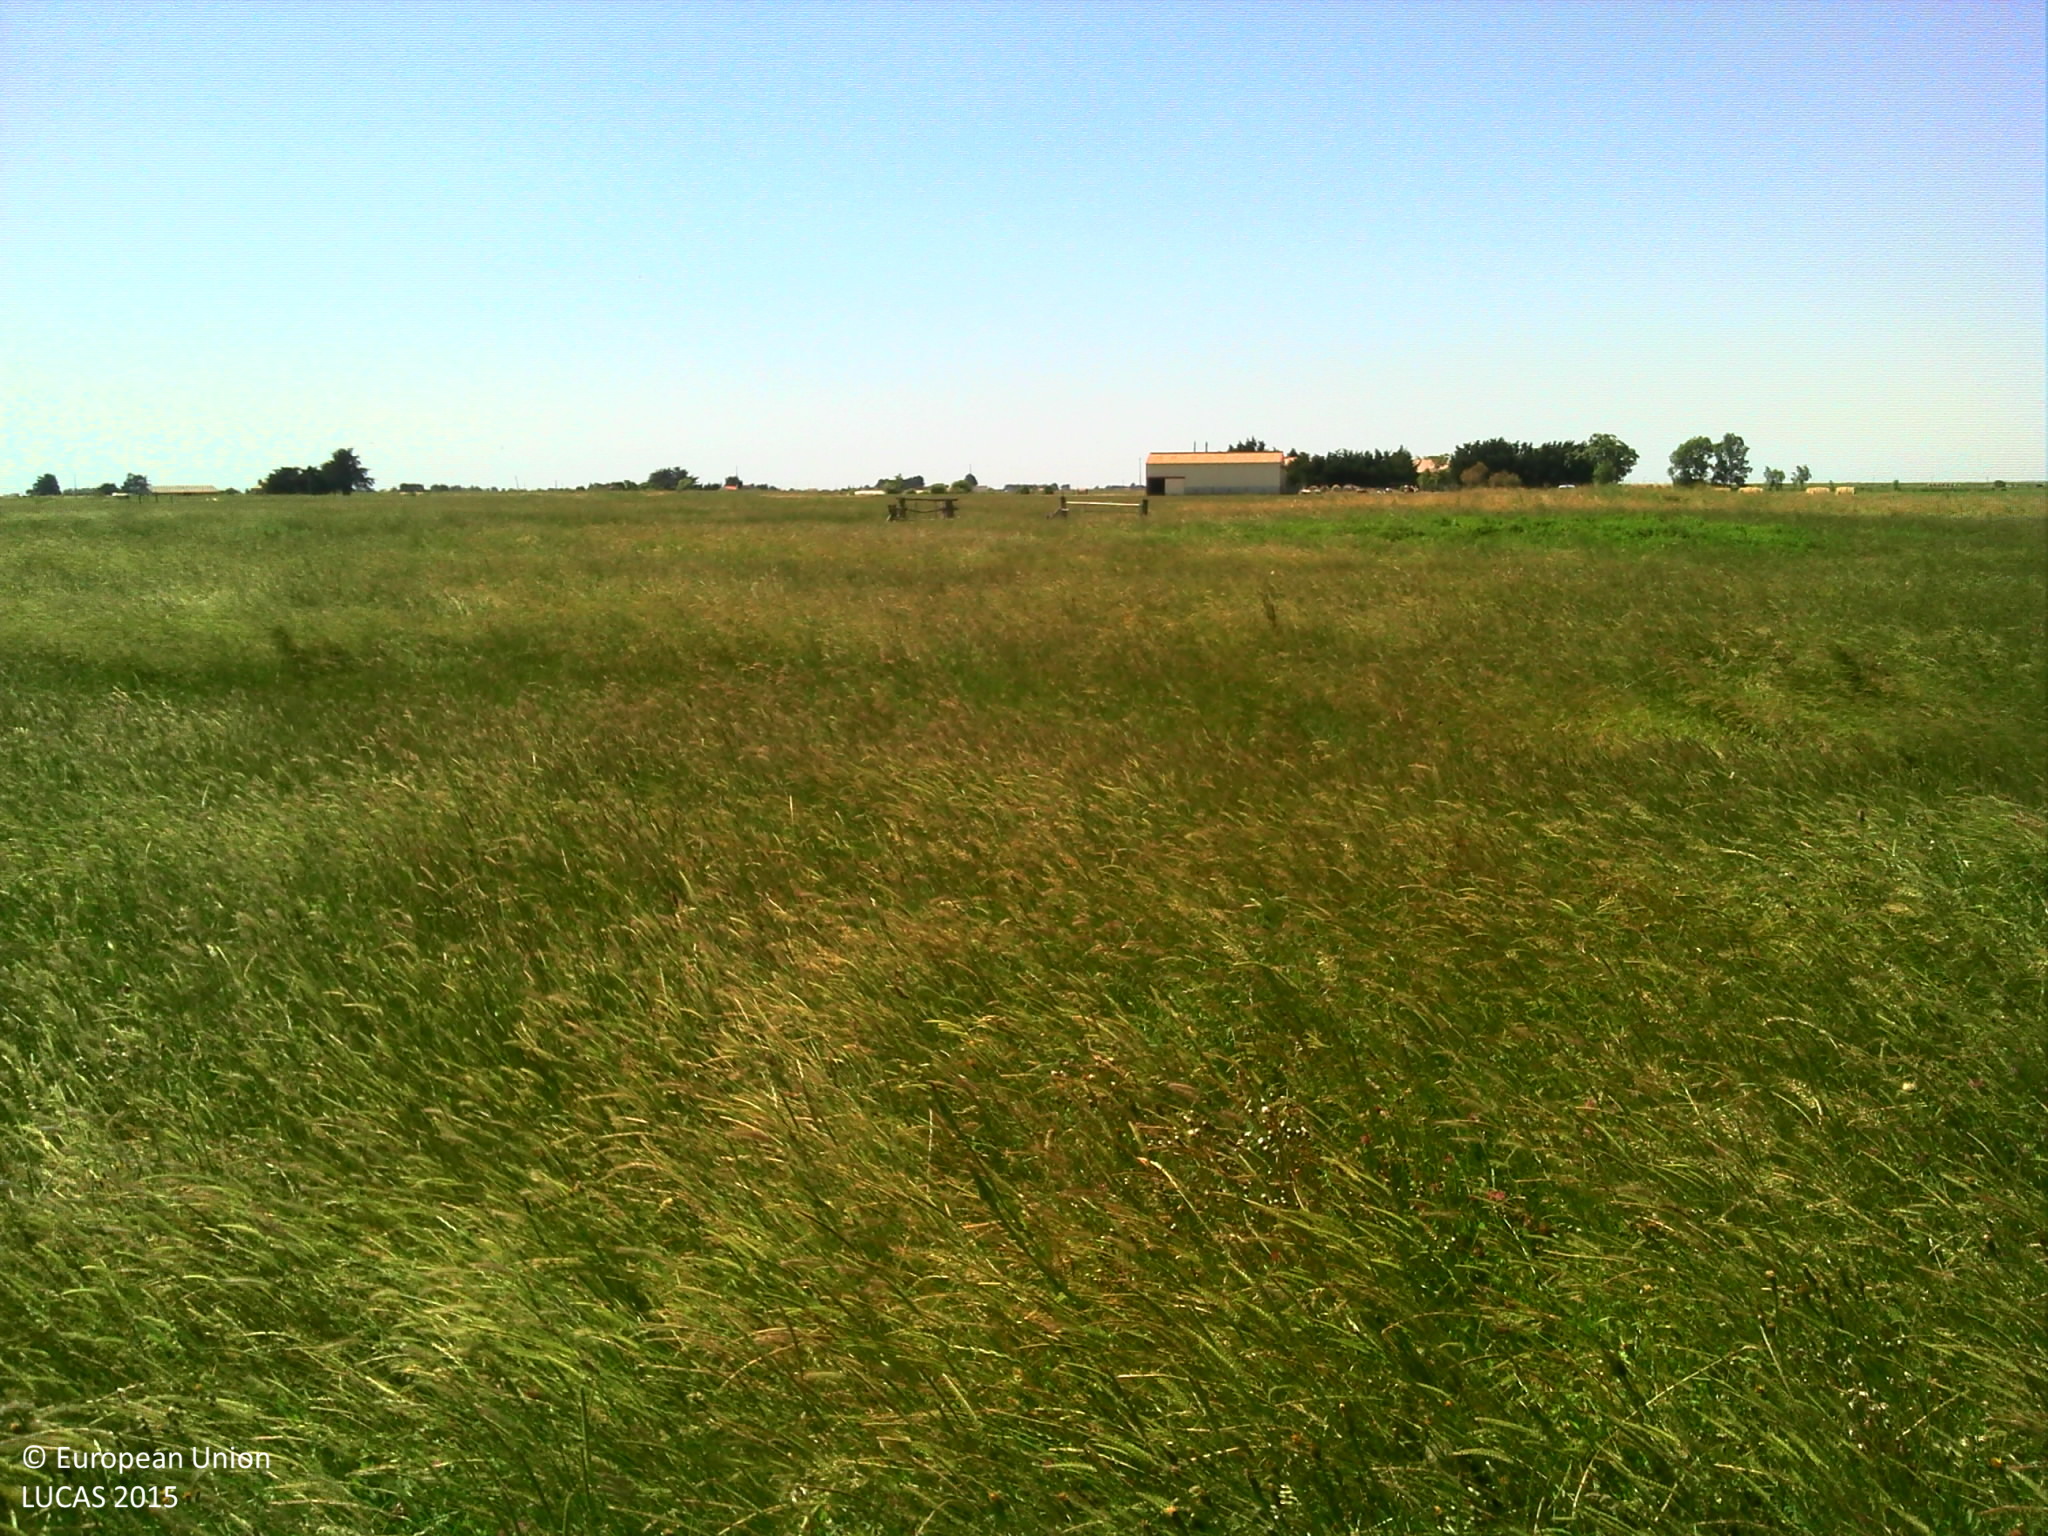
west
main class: Grassland
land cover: Grassland without tree/shrub cover
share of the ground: > 75 %
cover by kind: herbaceous plants 100 %
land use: Agriculture (excluding fallow land and kitchen gardens)
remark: Temporary flooded
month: June
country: FR
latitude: 47.0041
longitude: -1.9757
